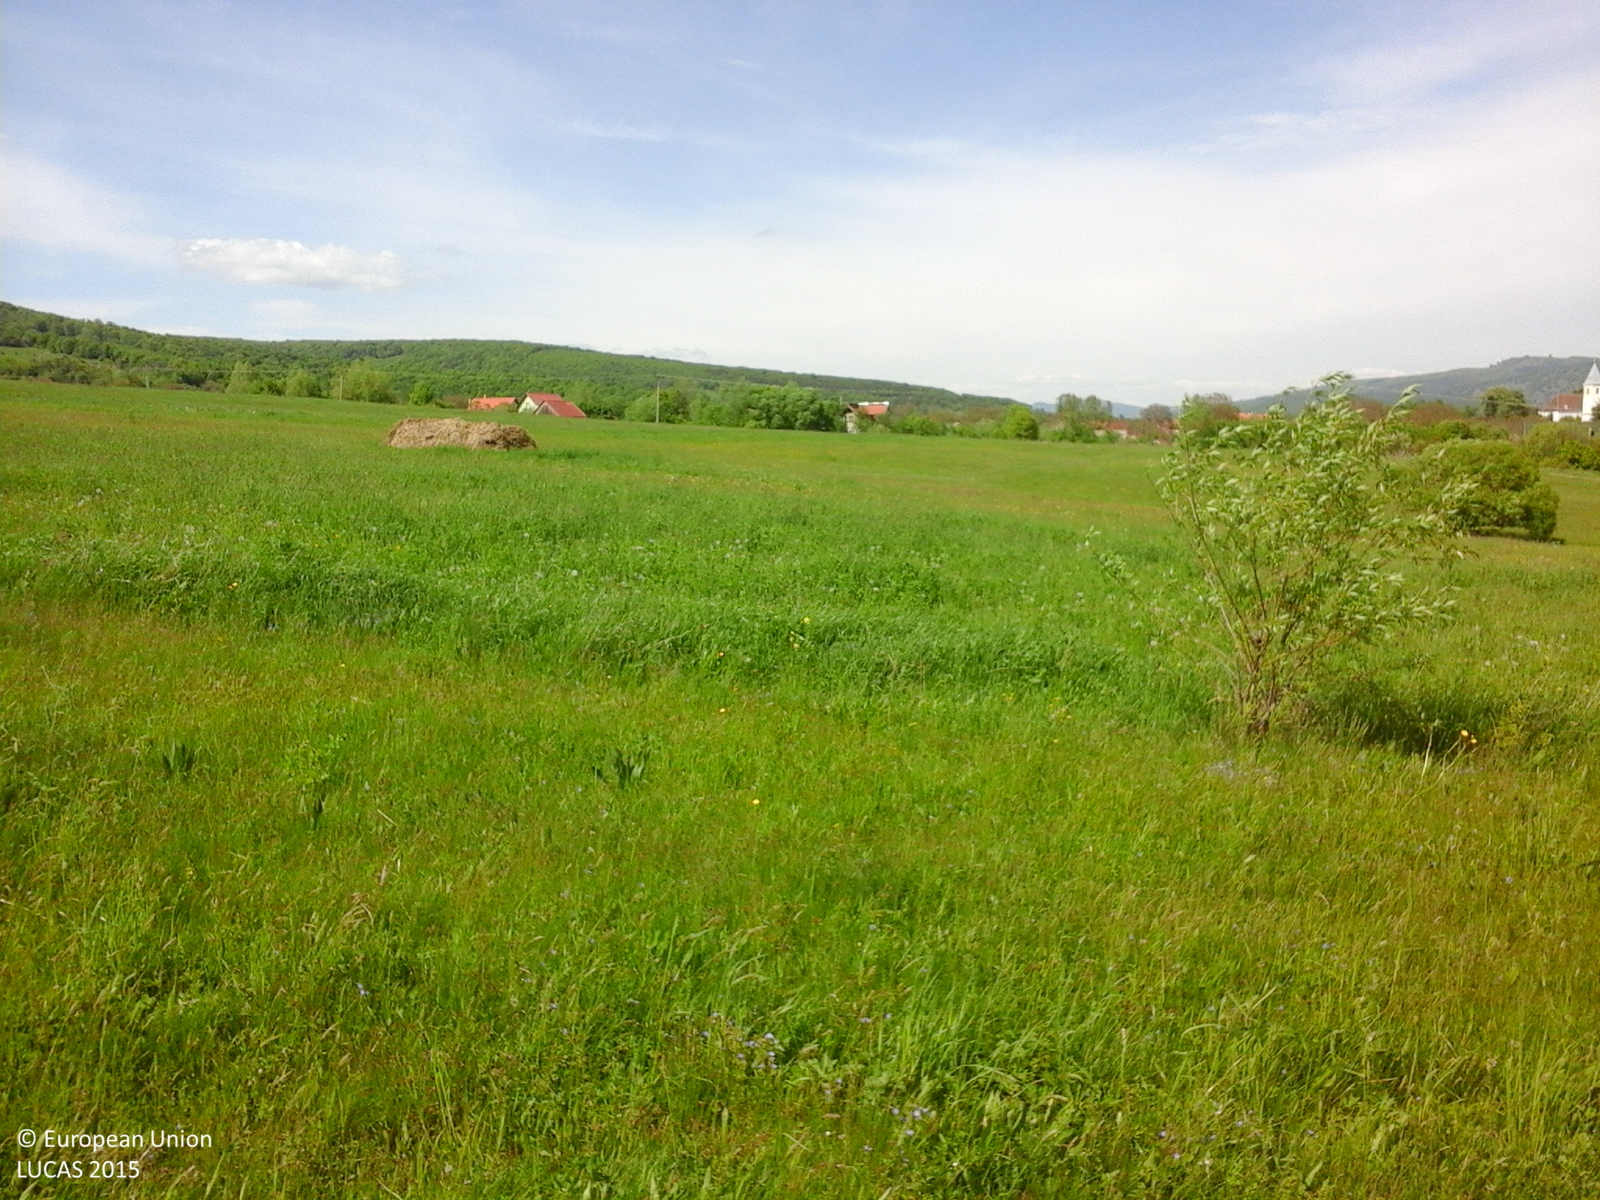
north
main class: Grassland
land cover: Grassland without tree/shrub cover
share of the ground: > 75 %
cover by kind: herbaceous plants 100 %
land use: Agriculture (excluding fallow land and kitchen gardens)
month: May
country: RO
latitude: 45.9541
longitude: 25.8135
